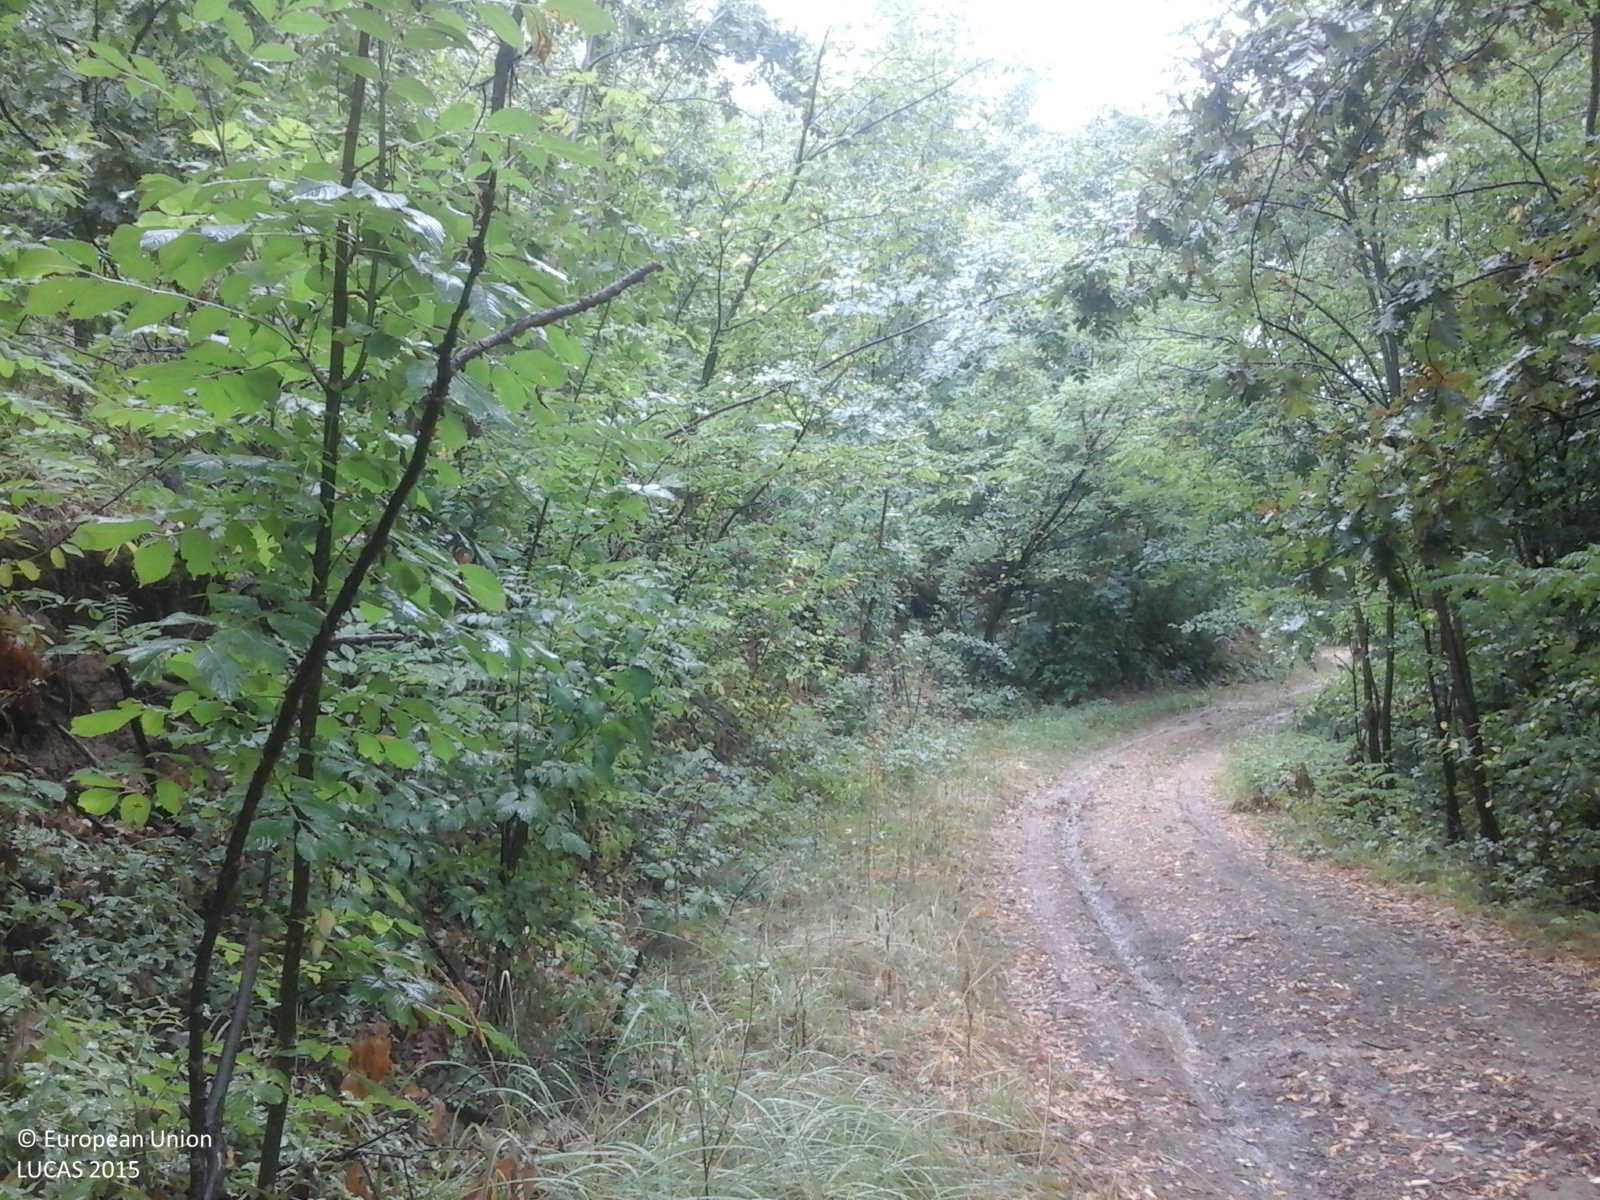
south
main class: Woodland
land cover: Broadleaved woodland
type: mesophytic deciduous forest
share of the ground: > 75 %
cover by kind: broadleaved forest trees 100 %
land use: Forestry
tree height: > 5 m
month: August
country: RO
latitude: 44.9673
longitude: 22.1193
